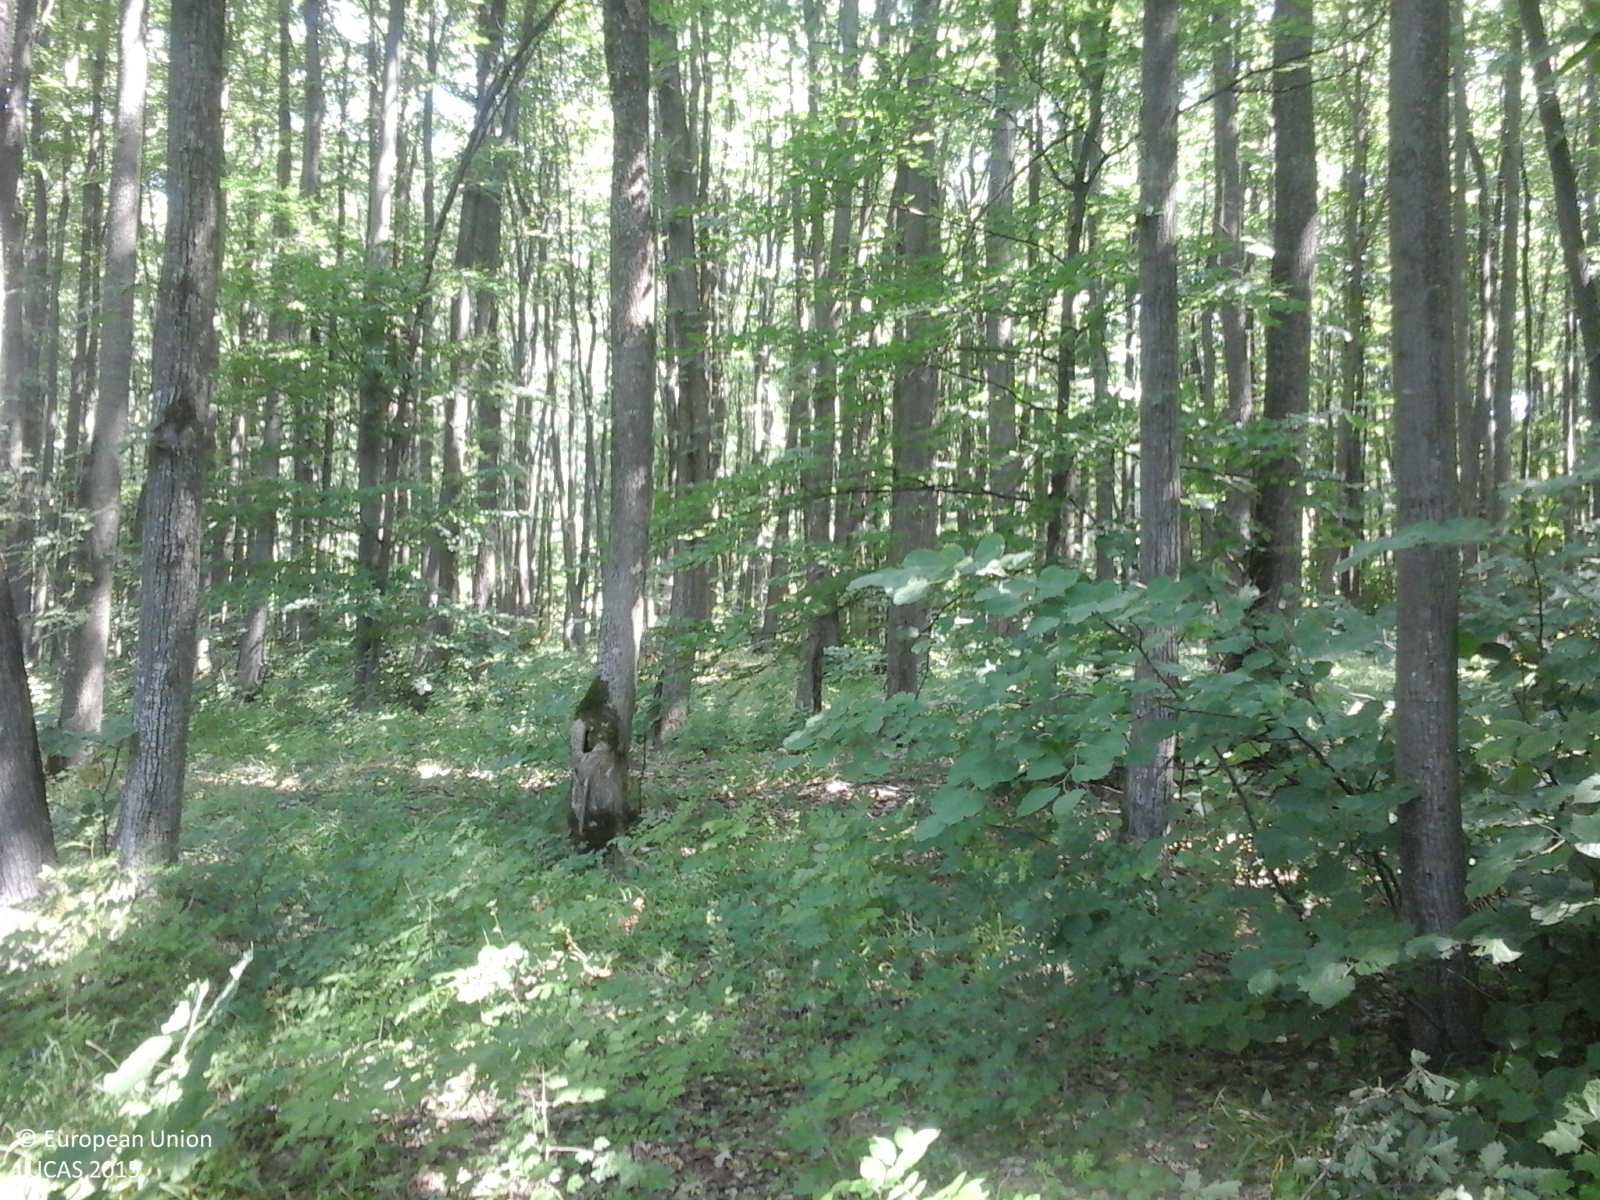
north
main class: Woodland
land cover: Broadleaved woodland
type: beech forest
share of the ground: > 75 %
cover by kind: broadleaved forest trees 95 %, herbaceous plants 5 %
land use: Forestry
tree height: > 5 m
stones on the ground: < 10 %
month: June
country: RO
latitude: 46.9376
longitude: 27.2759
